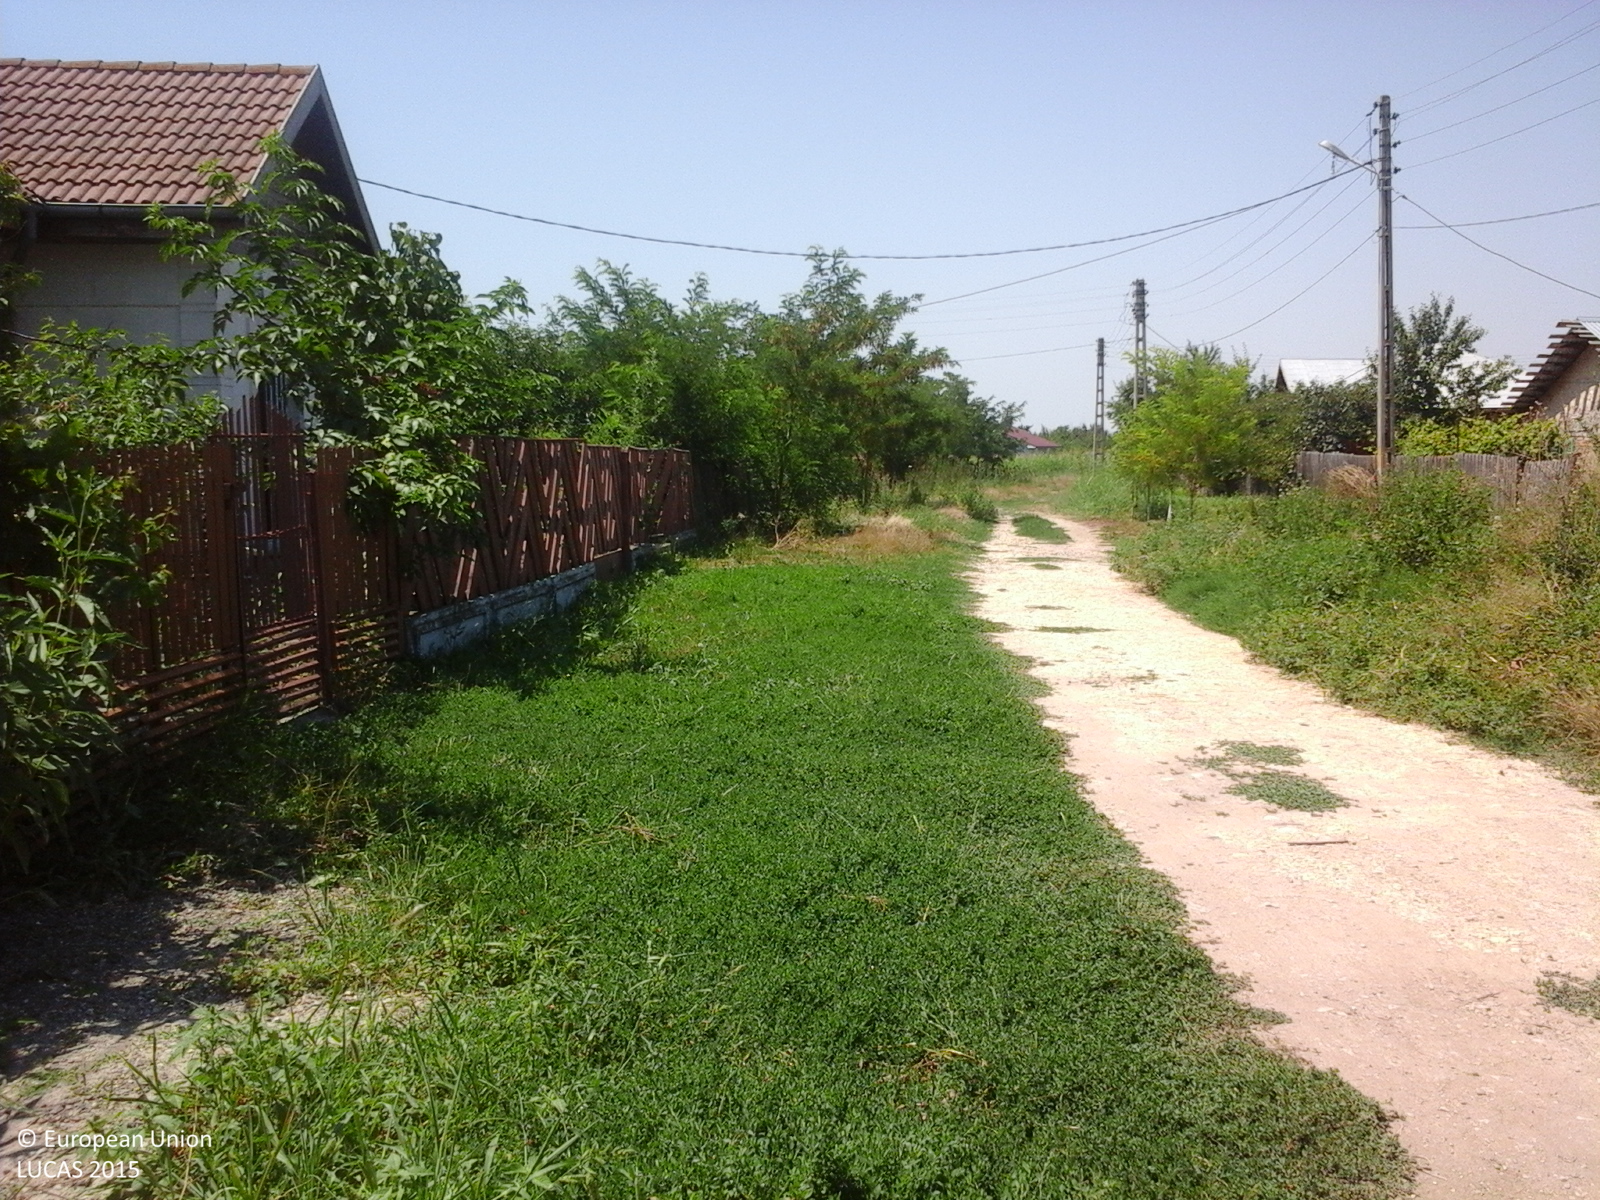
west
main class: Grassland
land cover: Grassland without tree/shrub cover
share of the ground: > 75 %
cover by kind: herbaceous plants 100 %
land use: Residential
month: July
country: RO
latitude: 44.5856
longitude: 27.2540
